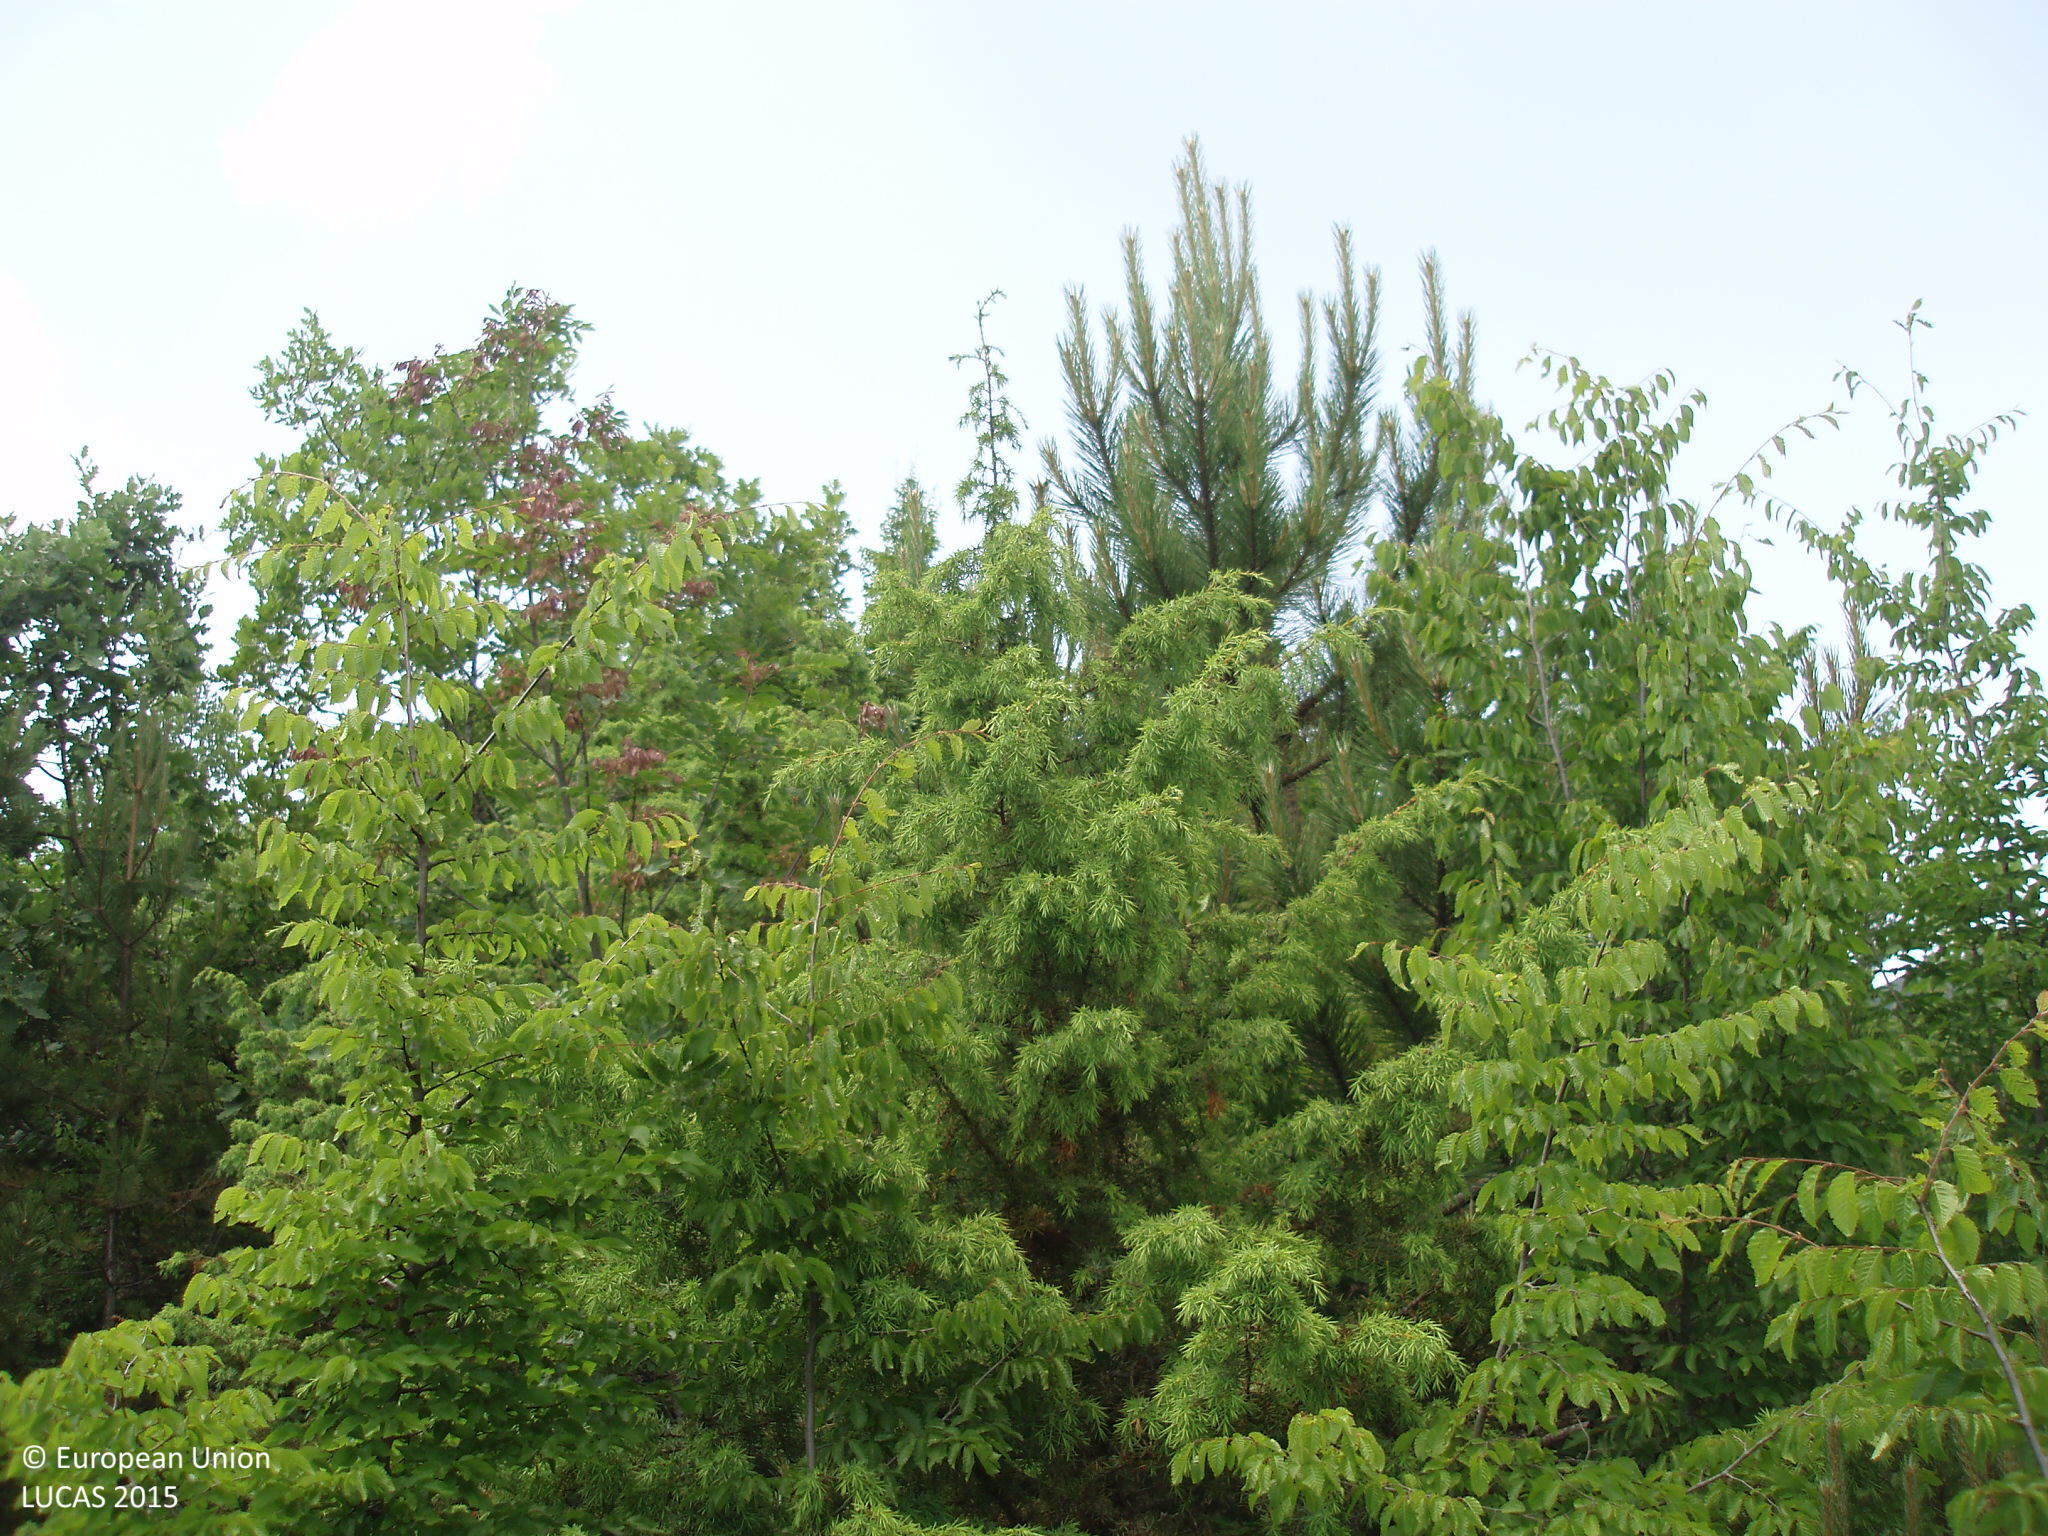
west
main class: Woodland
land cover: Other mixed woodland
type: hemiboreal forest and nemoral coniferous forest and mixed broadleaved-coniferous forest
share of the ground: > 75 %
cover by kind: coniferous forest trees 75 %, broadleaved forest trees 25 %
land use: Forestry
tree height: > 5 m
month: June
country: BG
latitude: 41.4073
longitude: 23.6989
